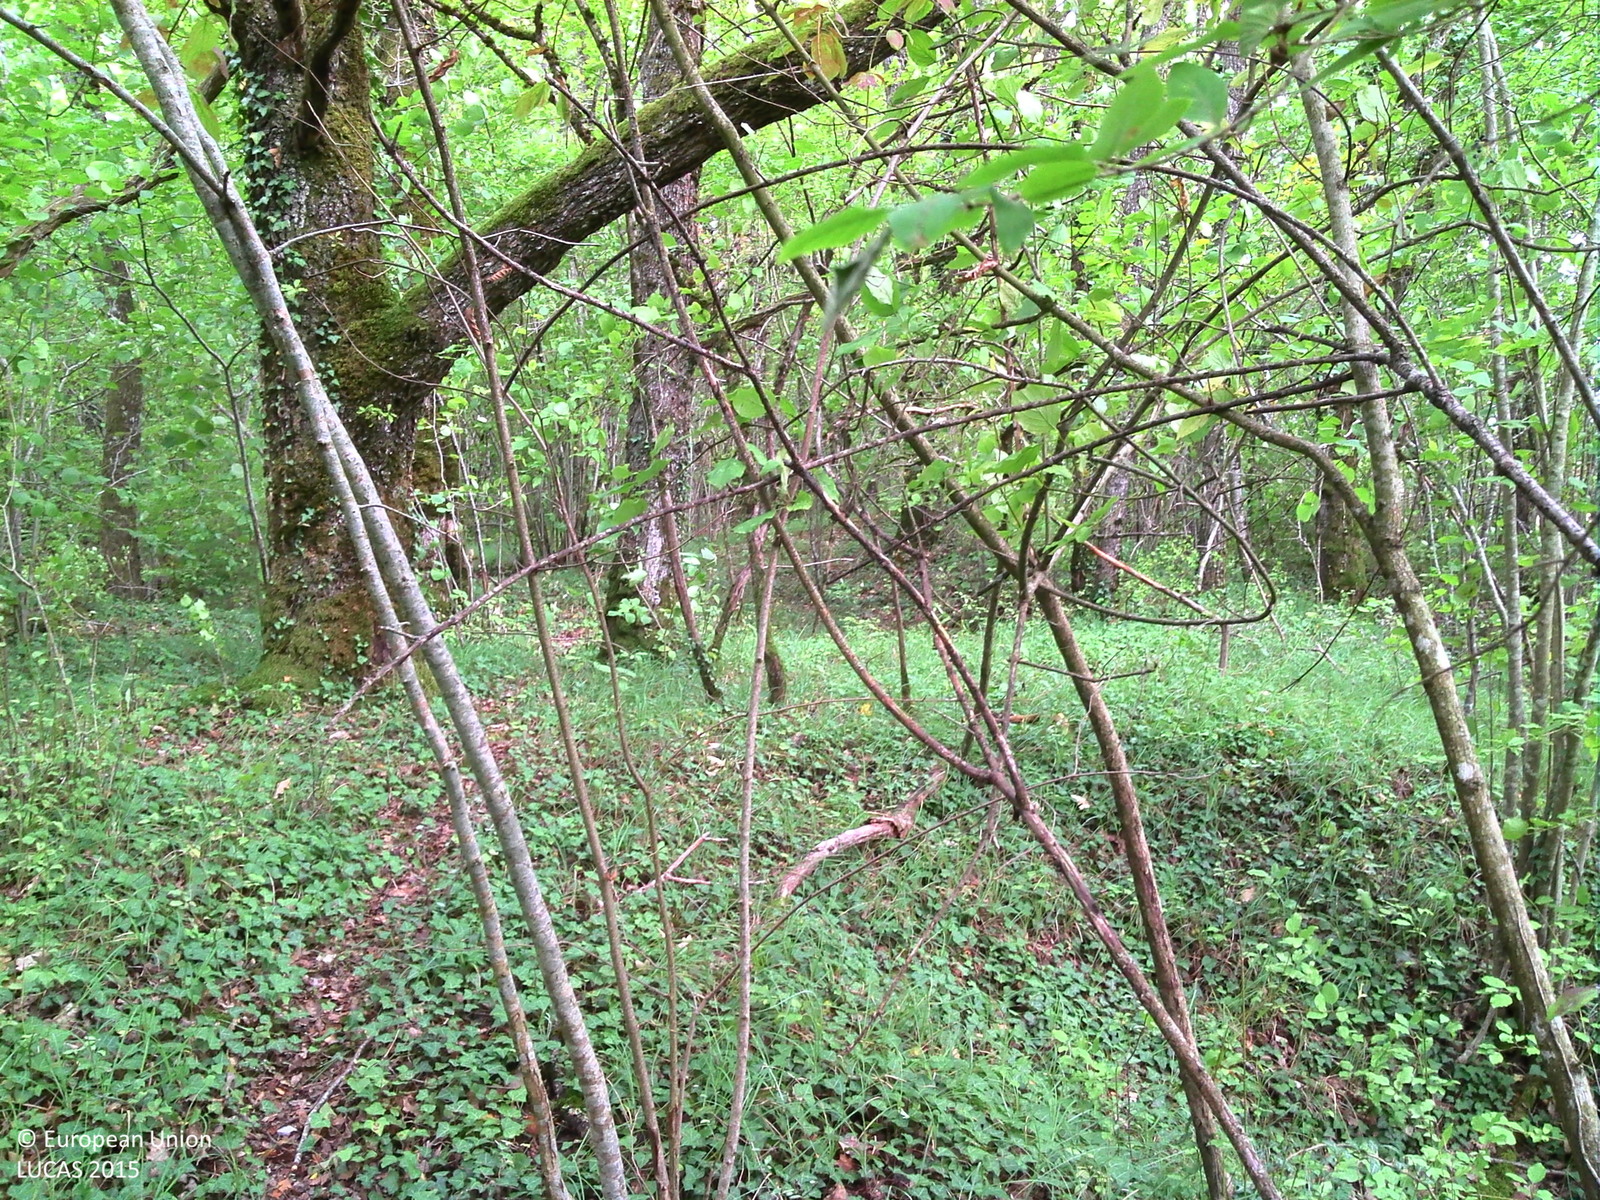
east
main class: Woodland
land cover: Broadleaved woodland
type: mesophytic deciduous forest
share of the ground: > 75 %
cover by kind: broadleaved forest trees 80 %, herbaceous plants 10 %, shrubs 5 %, lichens and mosses 5 %
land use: Forestry
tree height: > 5 m
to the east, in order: Broadleaved woodland; Tracks; Other bare soil; Broadleaved woodland; Other bare soil
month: September
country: FR
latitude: 48.2201
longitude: 4.6545
